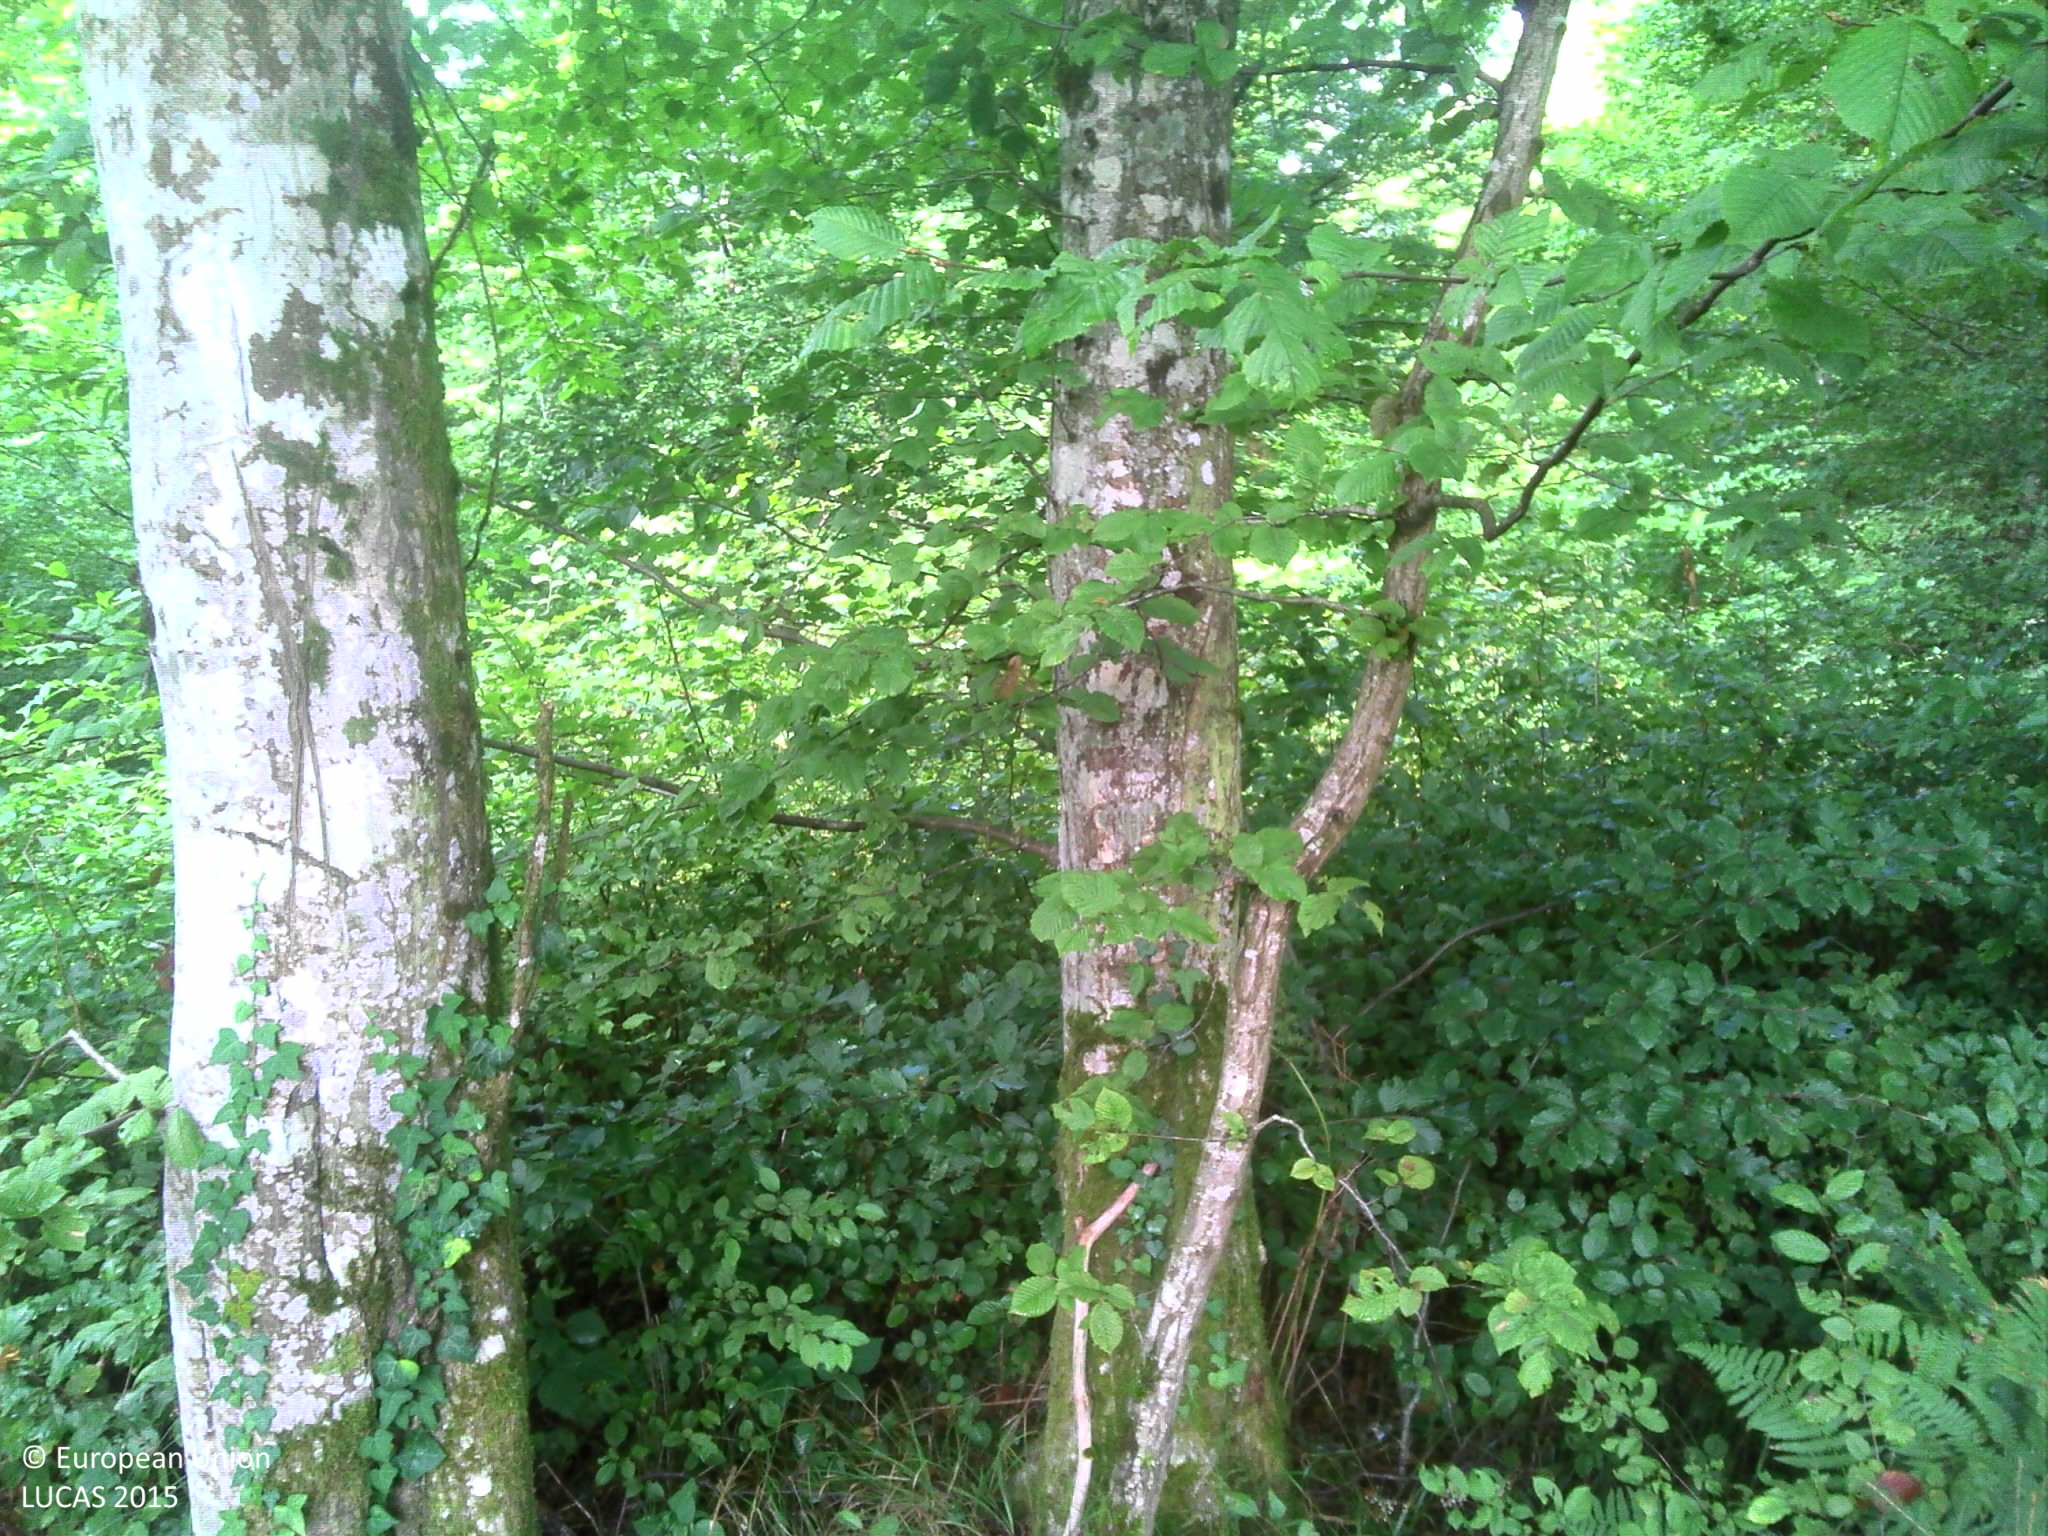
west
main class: Woodland
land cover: Broadleaved woodland
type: mesophytic deciduous forest
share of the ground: > 75 %
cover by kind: broadleaved forest trees 90 %, herbaceous plants 10 %
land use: Forestry
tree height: > 5 m
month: September
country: FR
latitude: 47.4951
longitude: 6.8823
